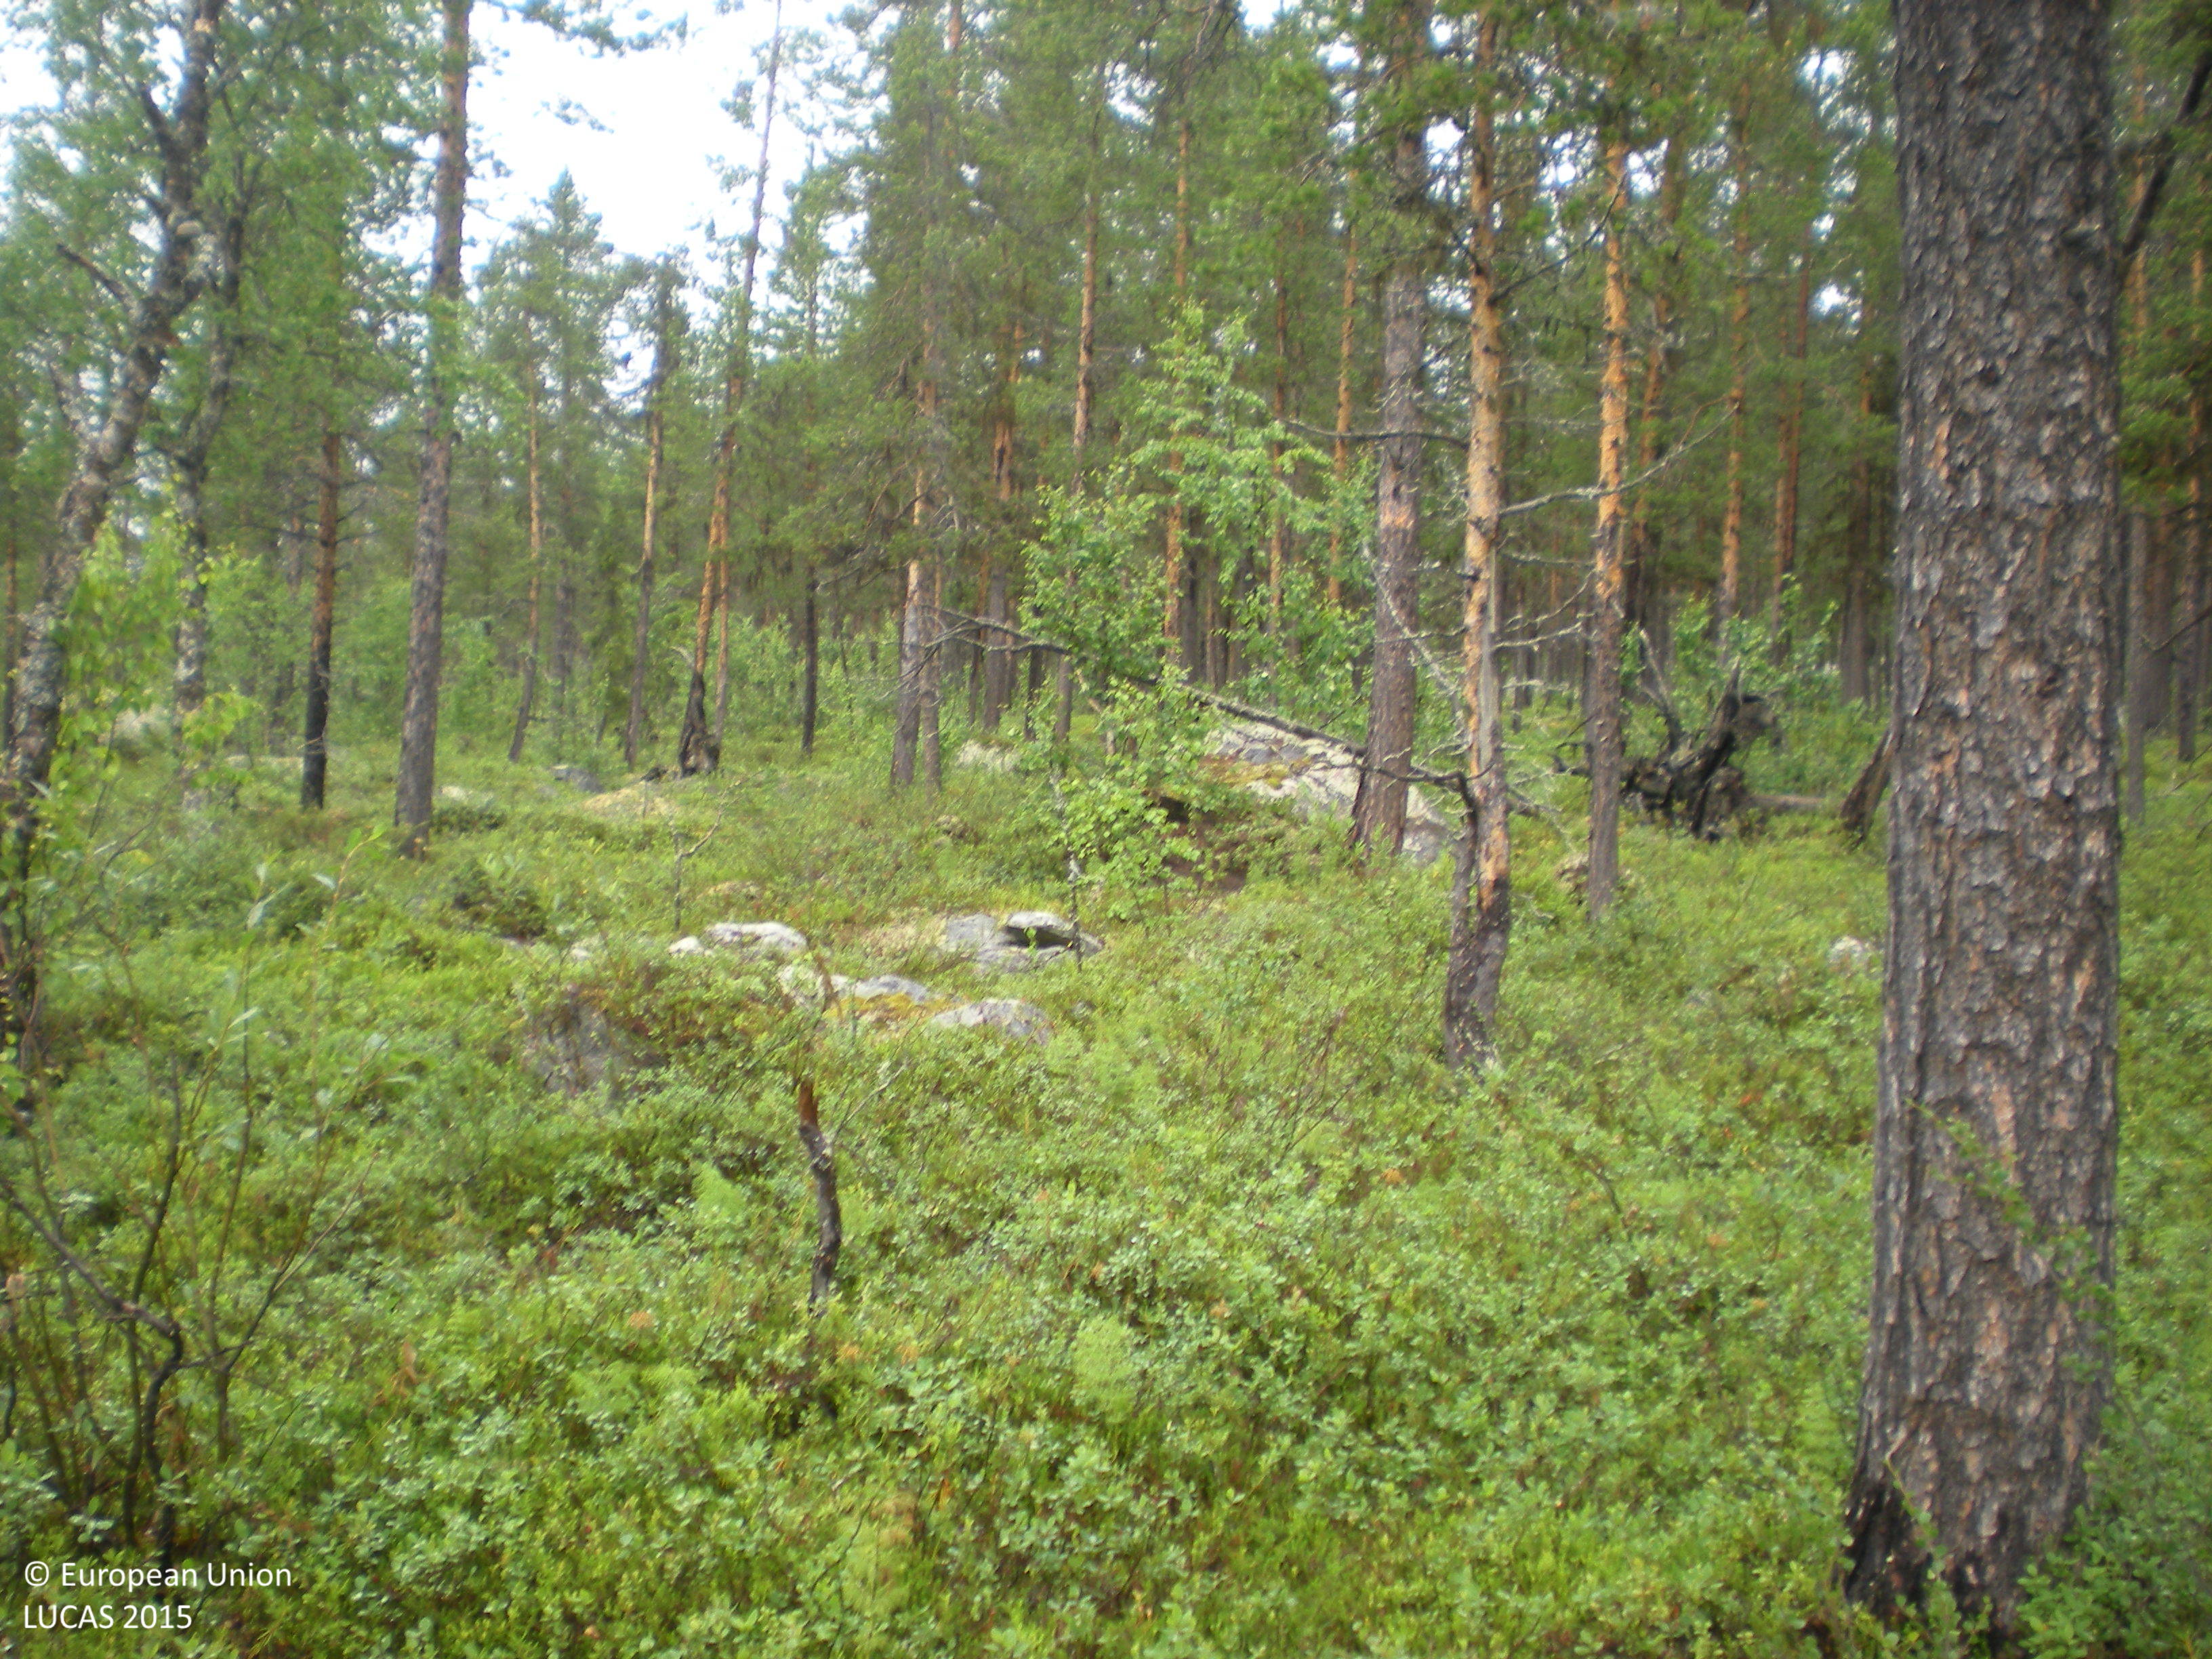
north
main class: Woodland
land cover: Pine dominated coniferous woodland
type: mire and swamp forests
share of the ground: 50 - 75 %
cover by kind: coniferous forest trees 60 %, shrubs 20 %, broadleaved forest trees 10 %, lichens and mosses 5 %, consolidated bare surface 5 %
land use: Forestry
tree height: > 5 m
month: August
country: SE
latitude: 66.1217
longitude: 18.0352
